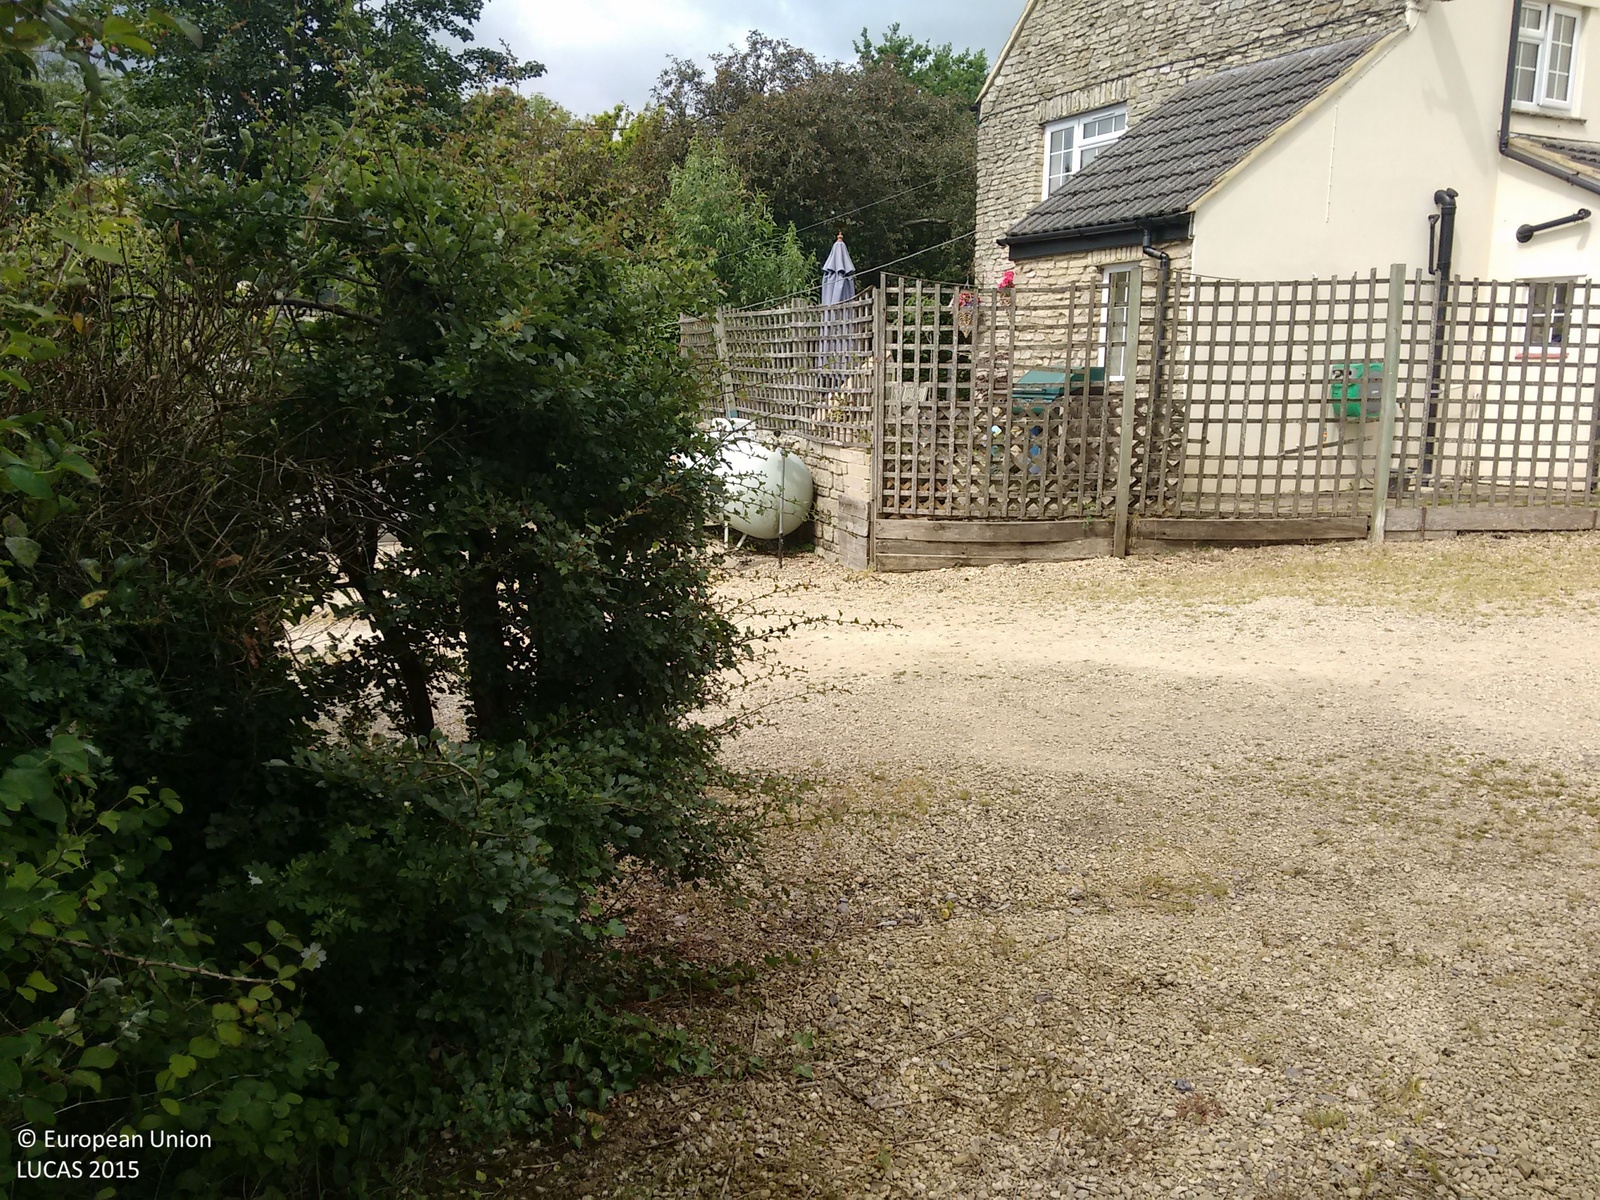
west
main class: Grassland
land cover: Grassland without tree/shrub cover
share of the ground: > 75 %
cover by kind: herbaceous plants 100 %
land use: Residential
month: June
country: GB
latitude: 51.5613
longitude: -2.0463
